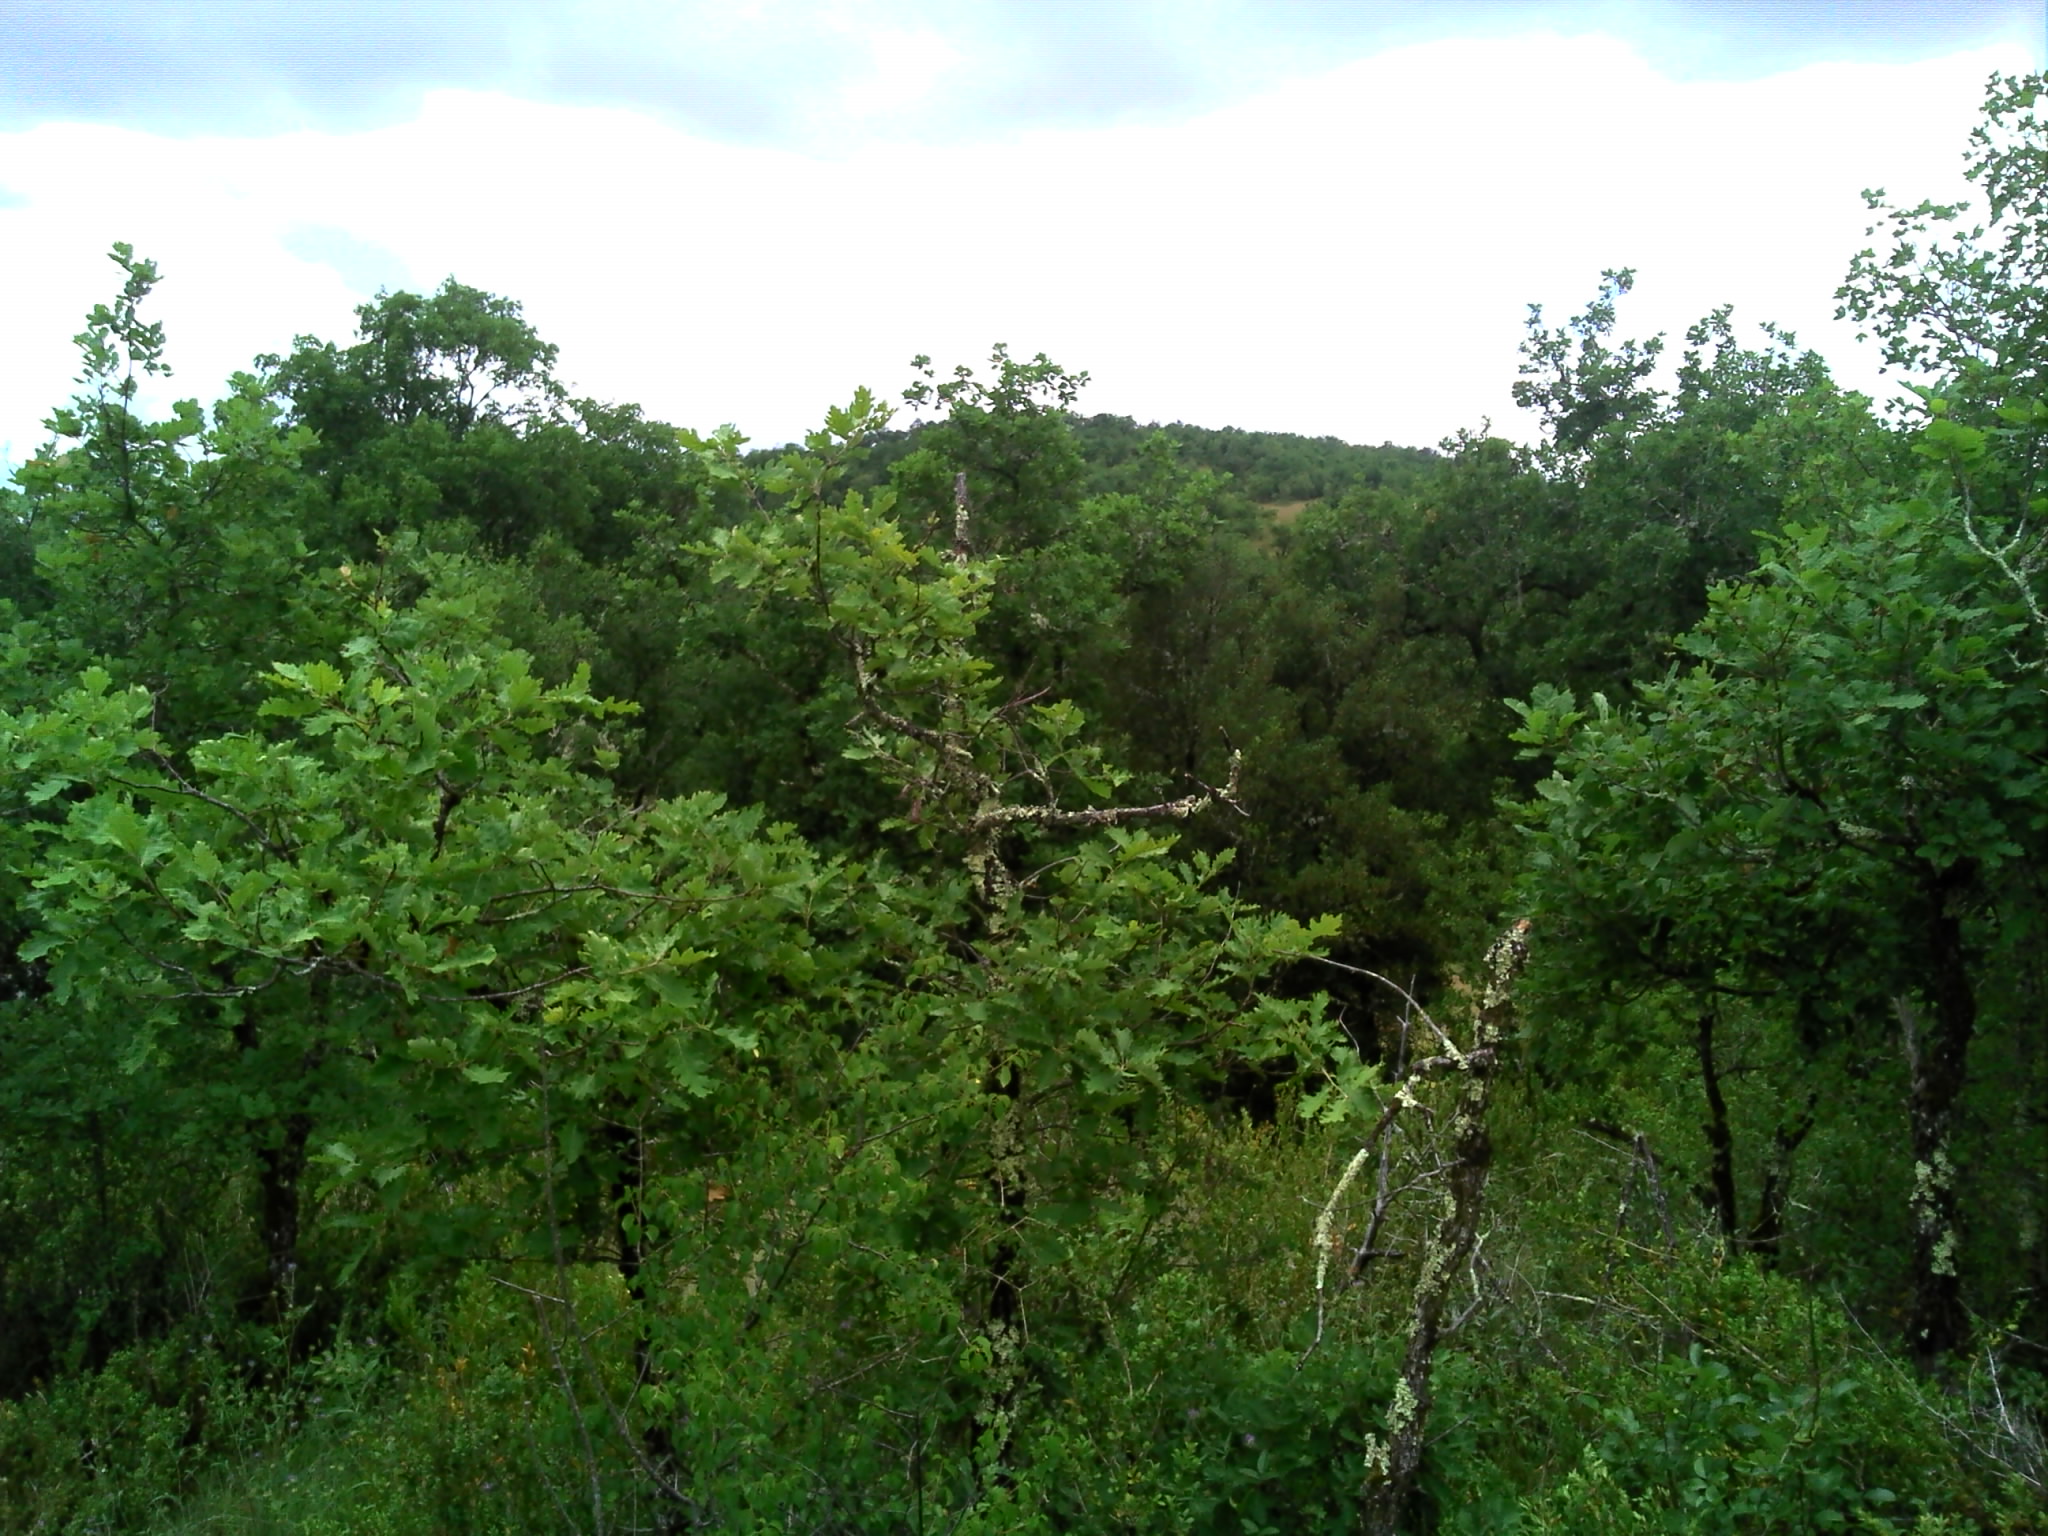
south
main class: Woodland
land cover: Broadleaved woodland
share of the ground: > 75 %
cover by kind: broadleaved forest trees 95 %, herbaceous plants 5 %
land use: Semi-natural and natural areas not in use
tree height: < 5 m
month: June
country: FR
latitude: 44.4378
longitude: 1.5182
